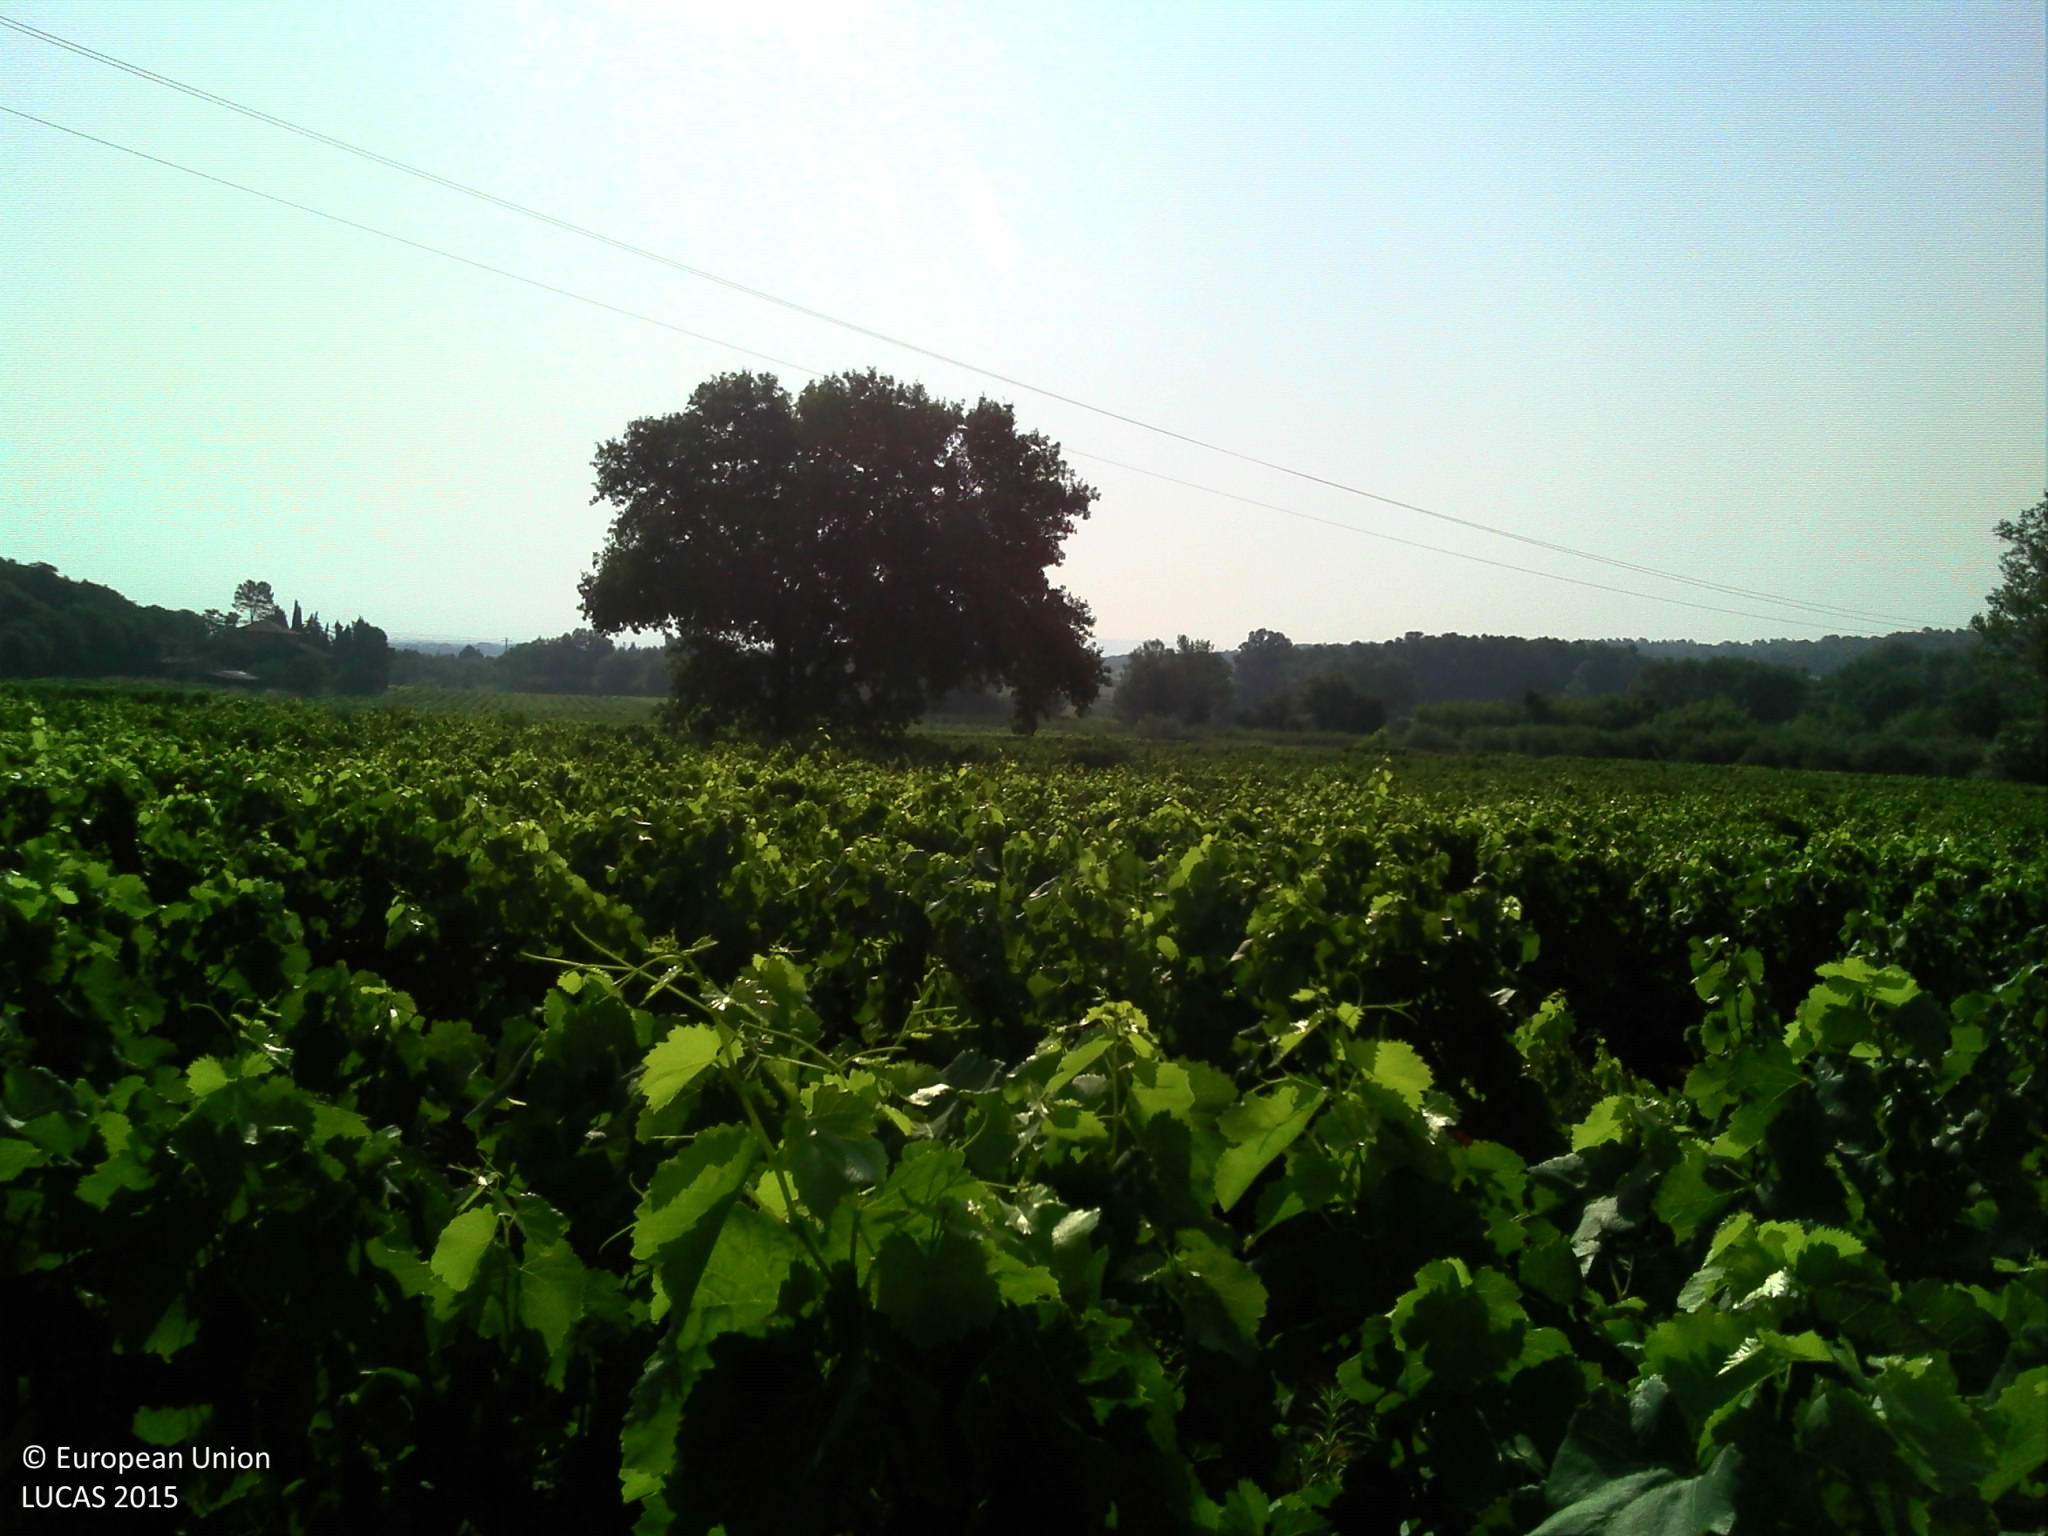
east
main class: Cropland
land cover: Vineyards
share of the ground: > 75 %
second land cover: Other bare soil
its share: > 75 %
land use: Agriculture (excluding fallow land and kitchen gardens)
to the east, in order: Vineyards; Other bare soil; Grass margins; Single bushes/trees; Tracks; Grass margins; Vineyards; Electric lines; Grass margins; Ditches and canals; Grass margins; Tracks; Vineyards; Tracks; Shrubland without tree cover; Tracks; Vineyards
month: July
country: FR
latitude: 44.2736
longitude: 4.7831
